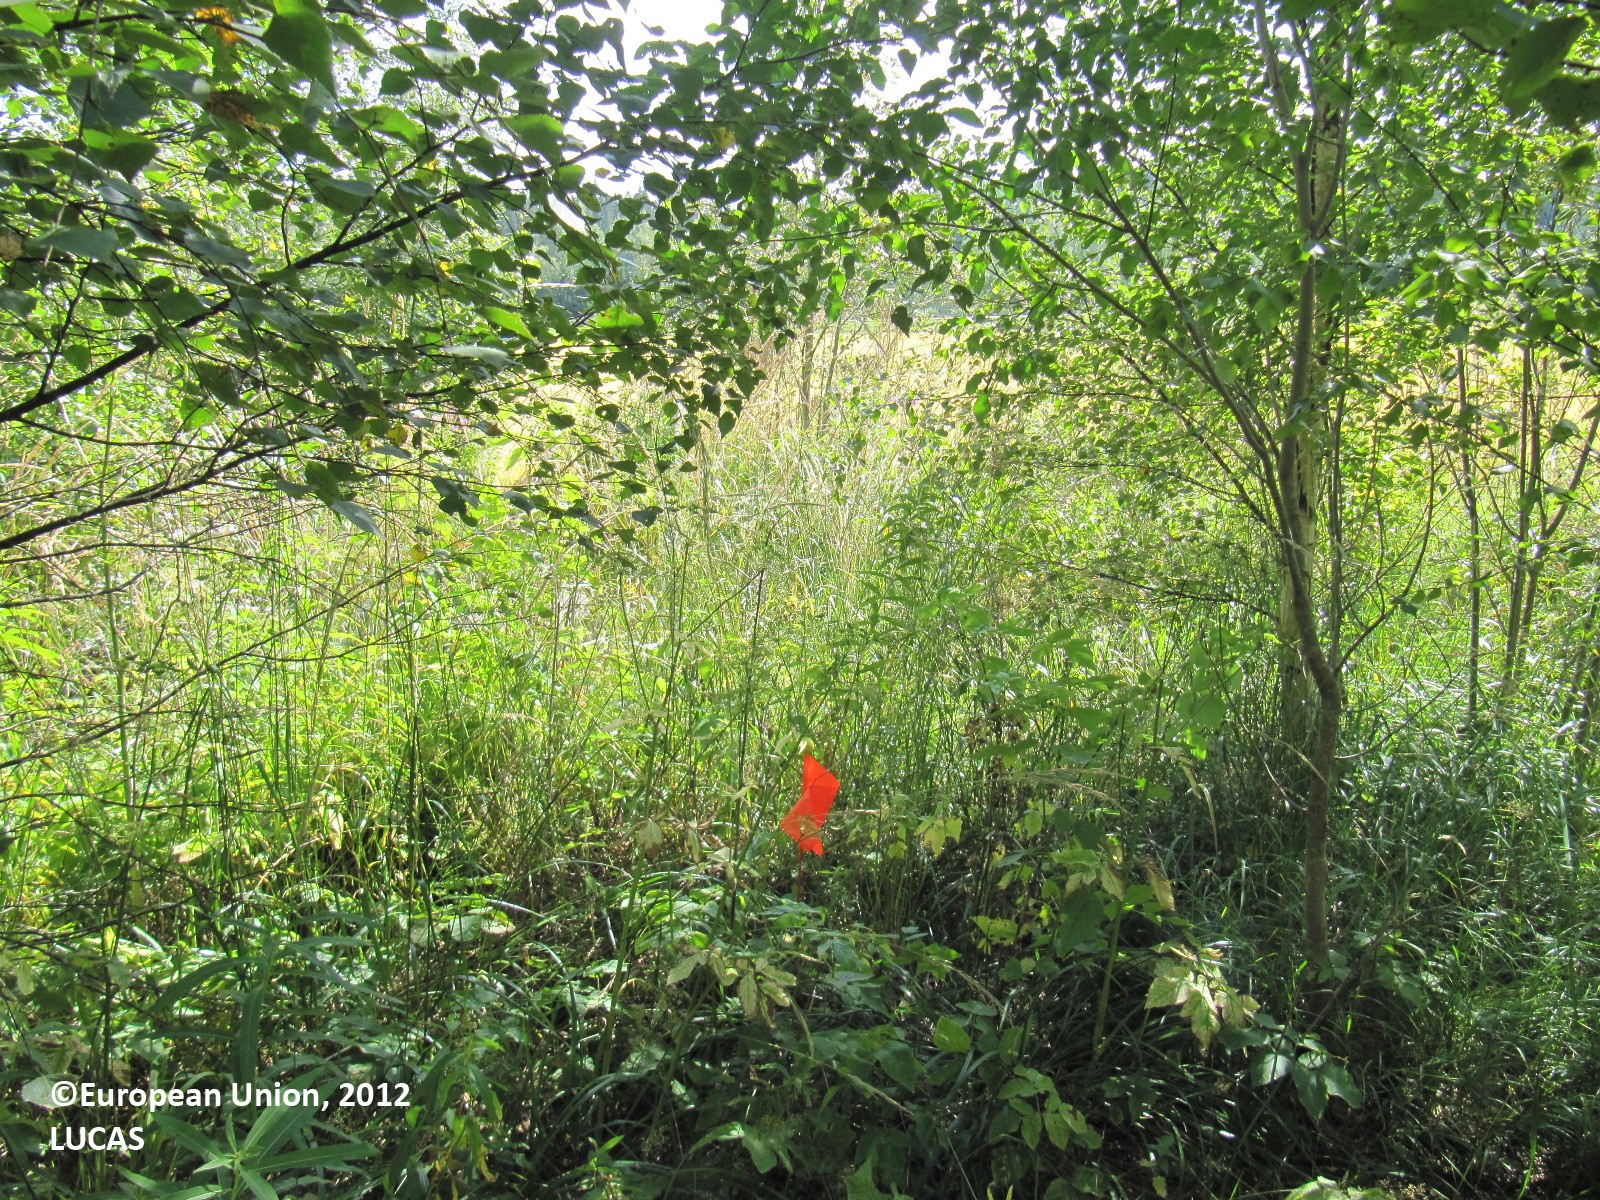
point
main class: Woodland
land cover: Broadleaved woodland
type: boreal forest
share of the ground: 50 - 75 %
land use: Forestry
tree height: > 5 m
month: August
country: FI
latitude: 60.4373
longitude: 24.4791
